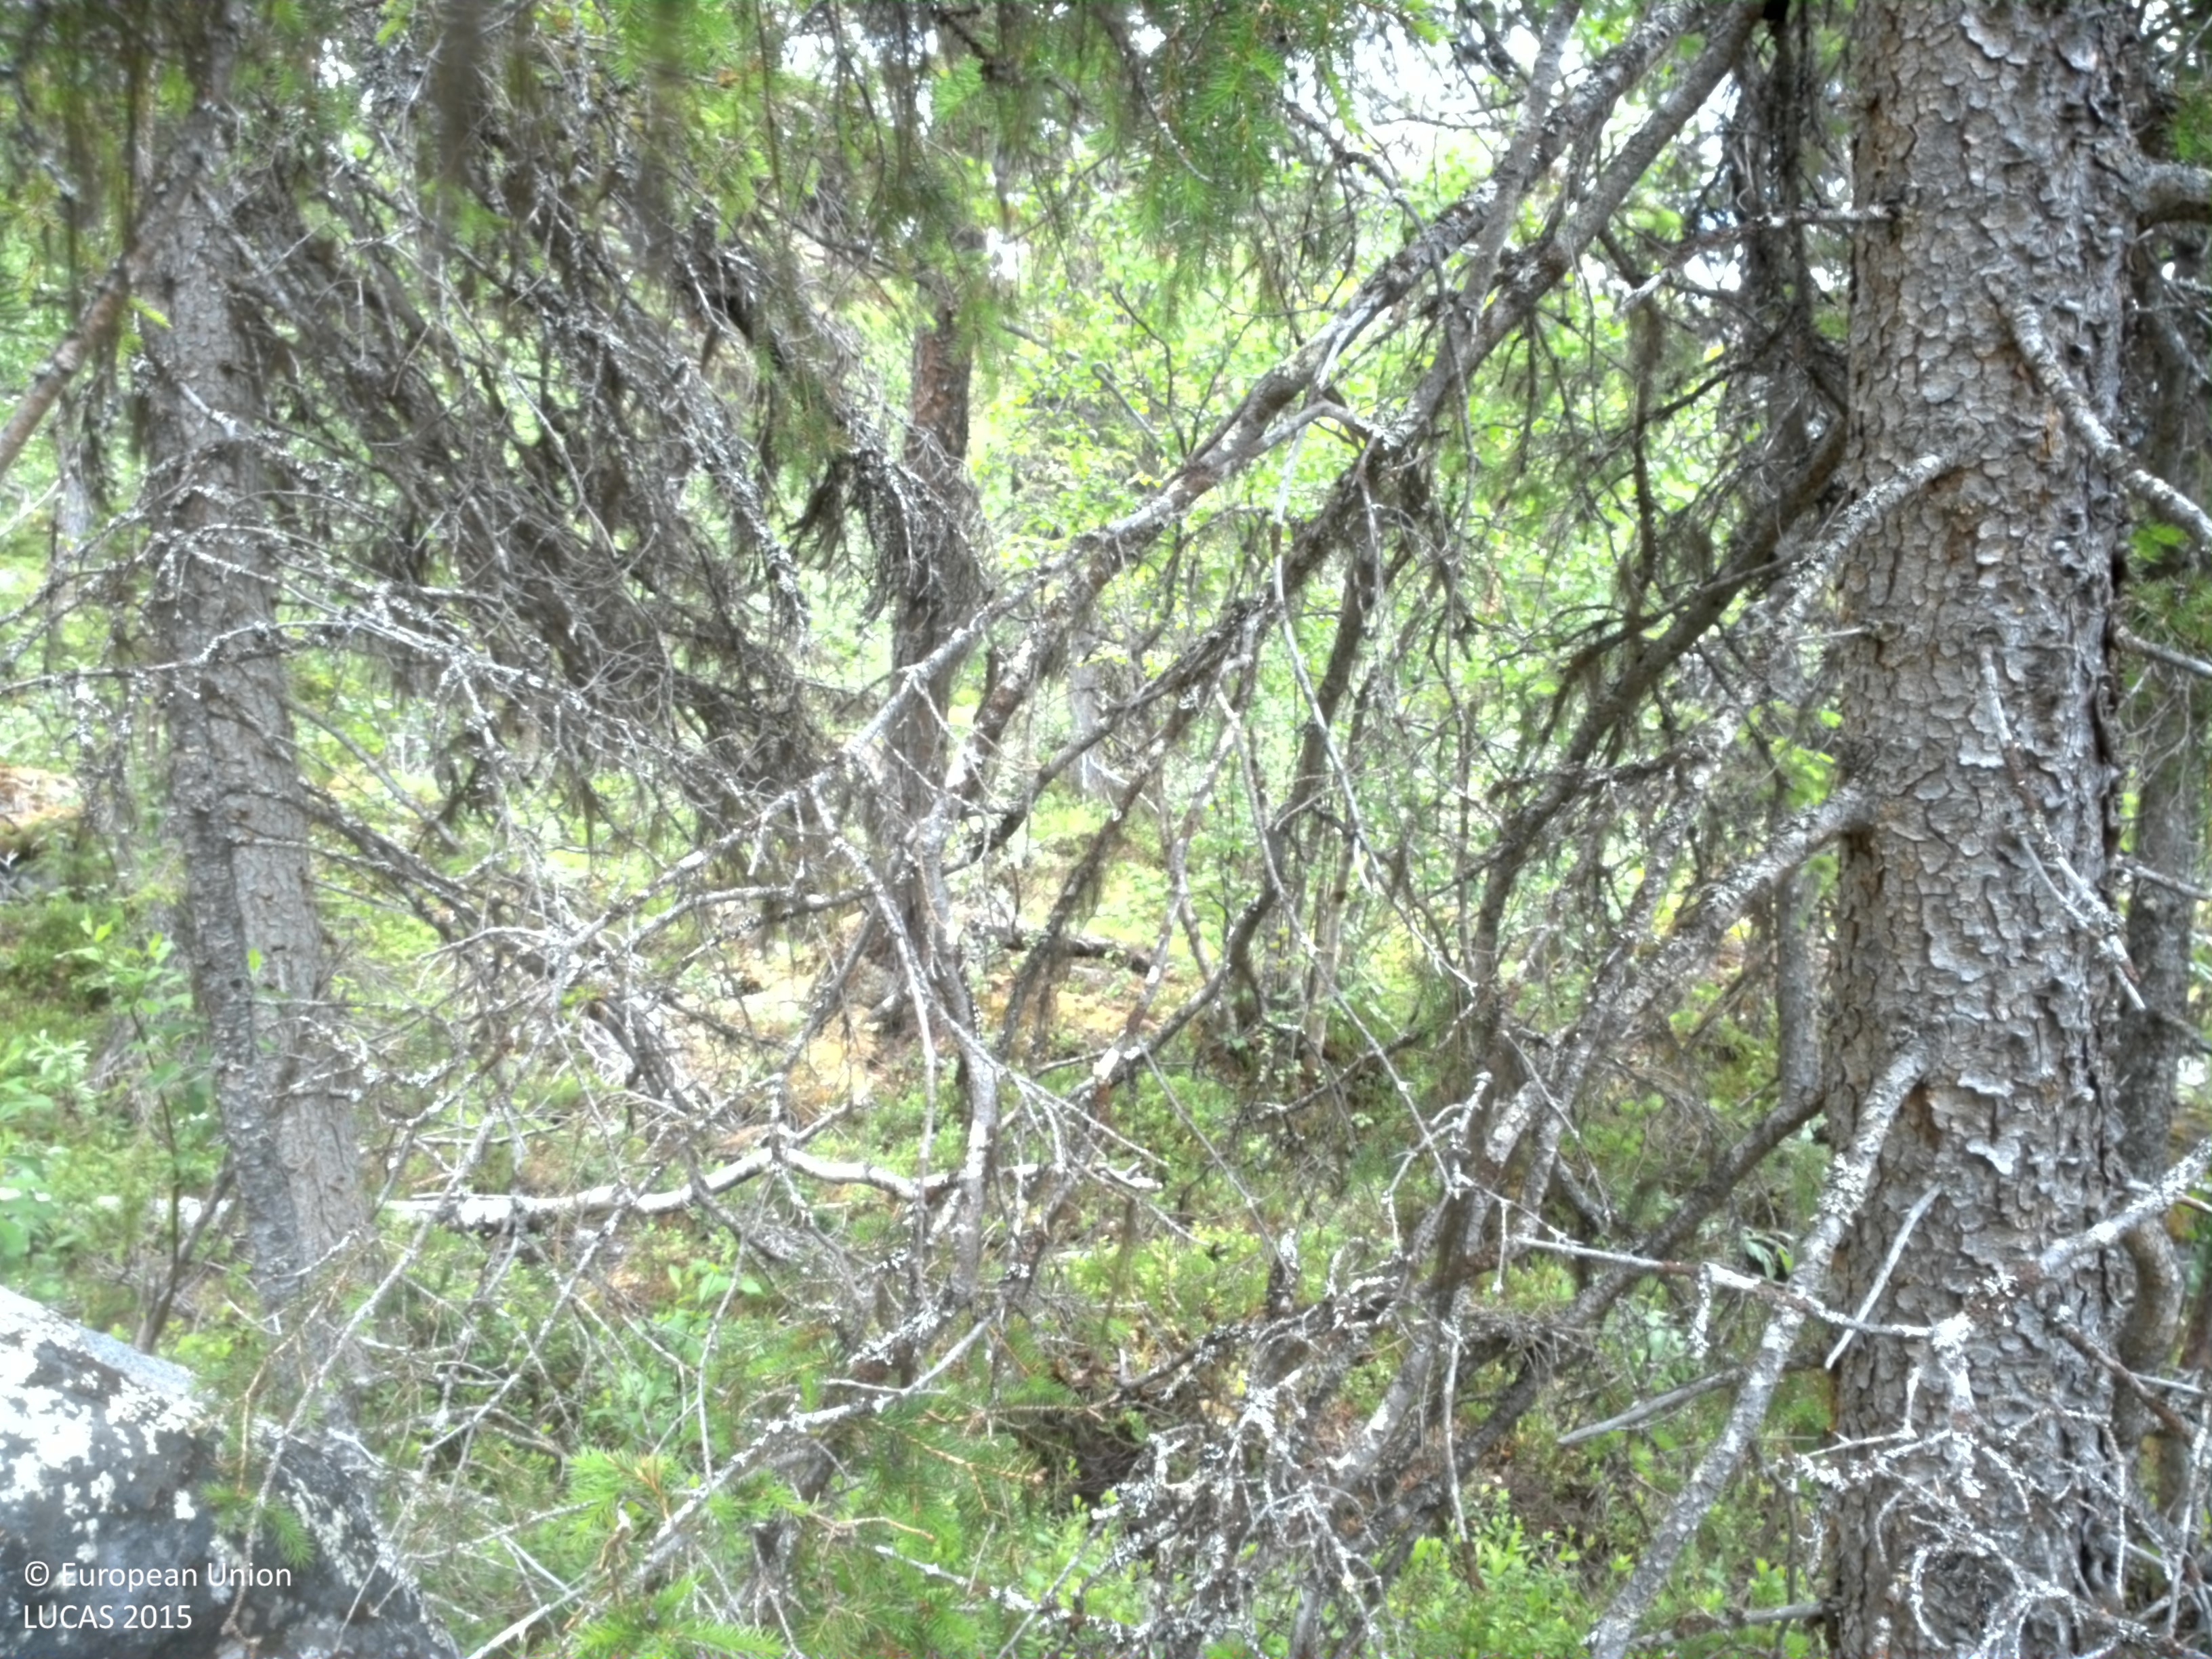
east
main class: Woodland
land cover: Spruce dominated mixed woodland
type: boreal forest
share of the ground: 50 - 75 %
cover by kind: coniferous forest trees 40 %, shrubs 35 %, broadleaved forest trees 20 %, lichens and mosses 5 %
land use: Forestry
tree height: > 5 m
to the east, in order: Spruce dominated mixed woodland; Pine dominated coniferous woodland; Spruce dominated mixed woodland; Broadleaved woodland; Spruce dominated mixed woodland
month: July
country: SE
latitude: 67.3141
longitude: 18.9815
